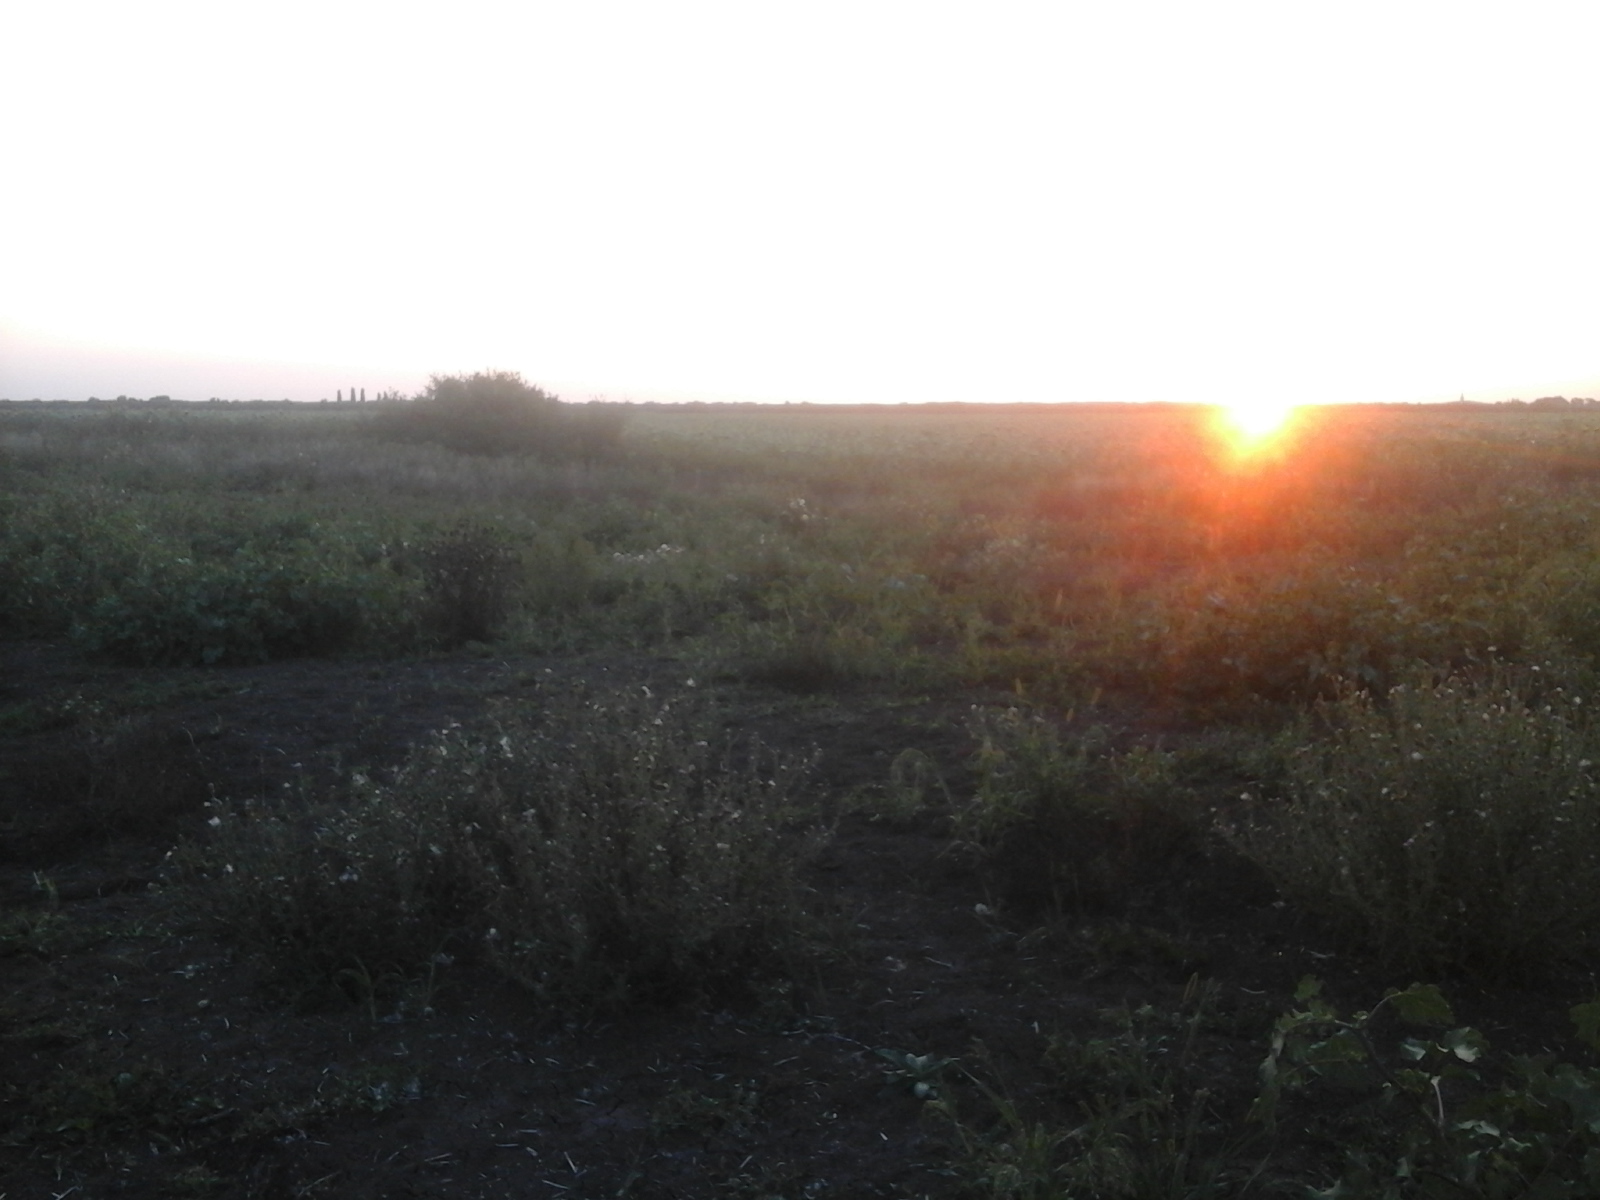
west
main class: Grassland
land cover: Spontaneously vegetated surfaces
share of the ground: > 75 %
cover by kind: herbaceous plants 100 %
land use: Agriculture (excluding fallow land and kitchen gardens)
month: August
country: RO
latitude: 46.6562
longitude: 21.4990
